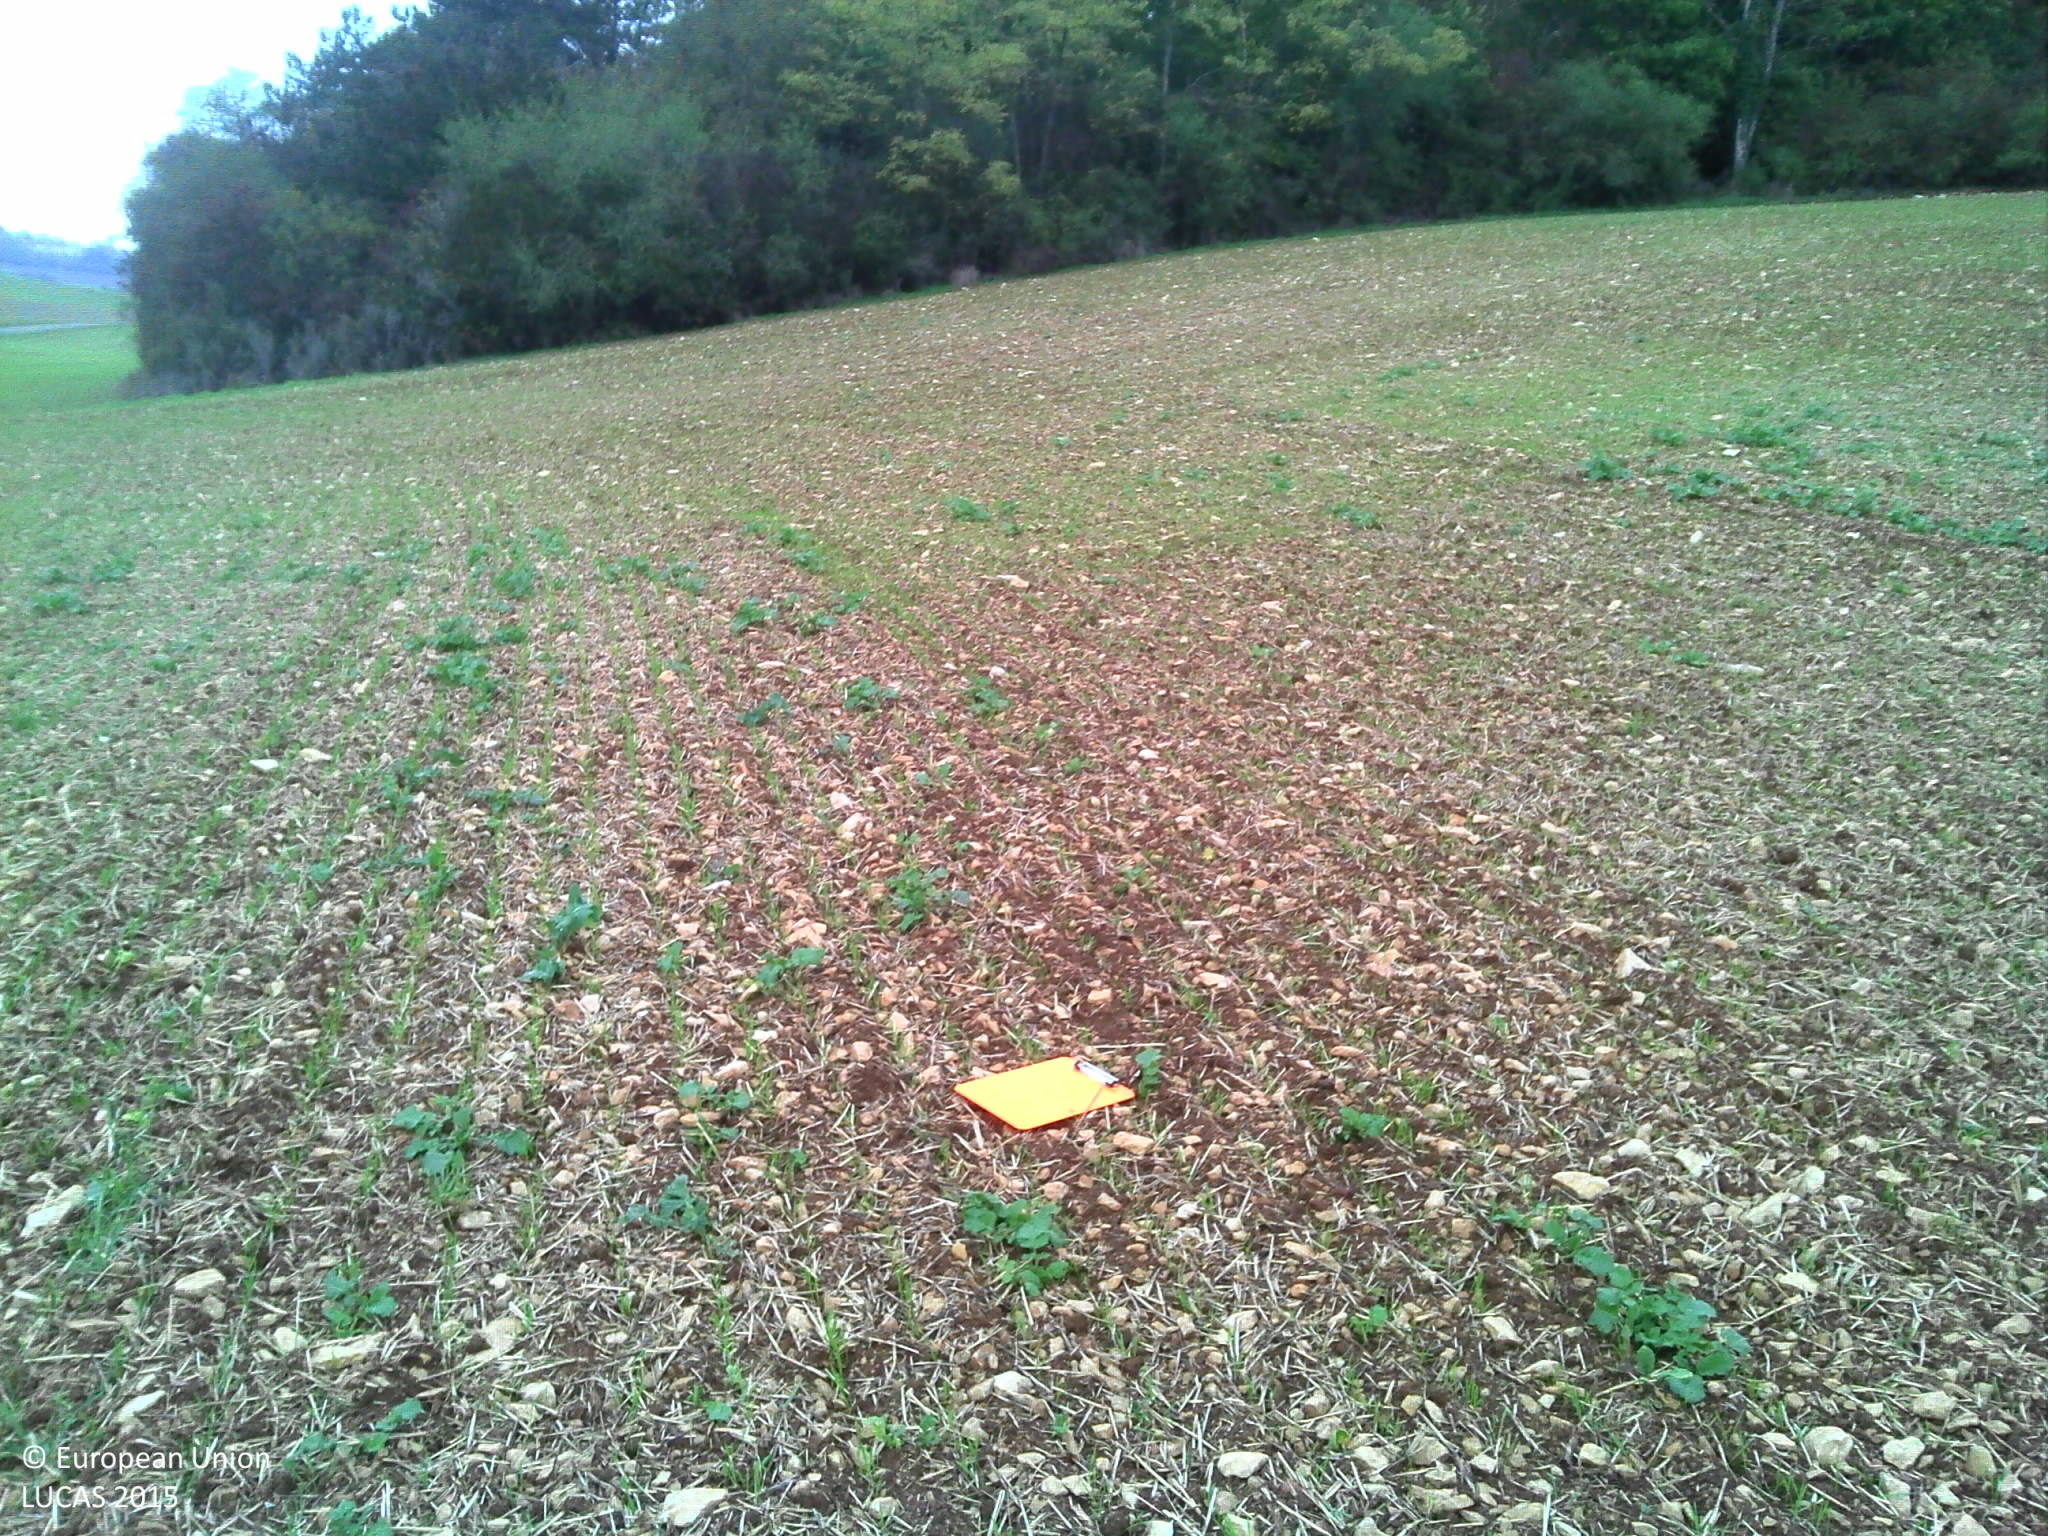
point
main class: Cropland
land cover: Common wheat
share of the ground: 10 - 25 %
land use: Agriculture (excluding fallow land and kitchen gardens)
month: October
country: FR
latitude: 47.5352
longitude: 5.0451
